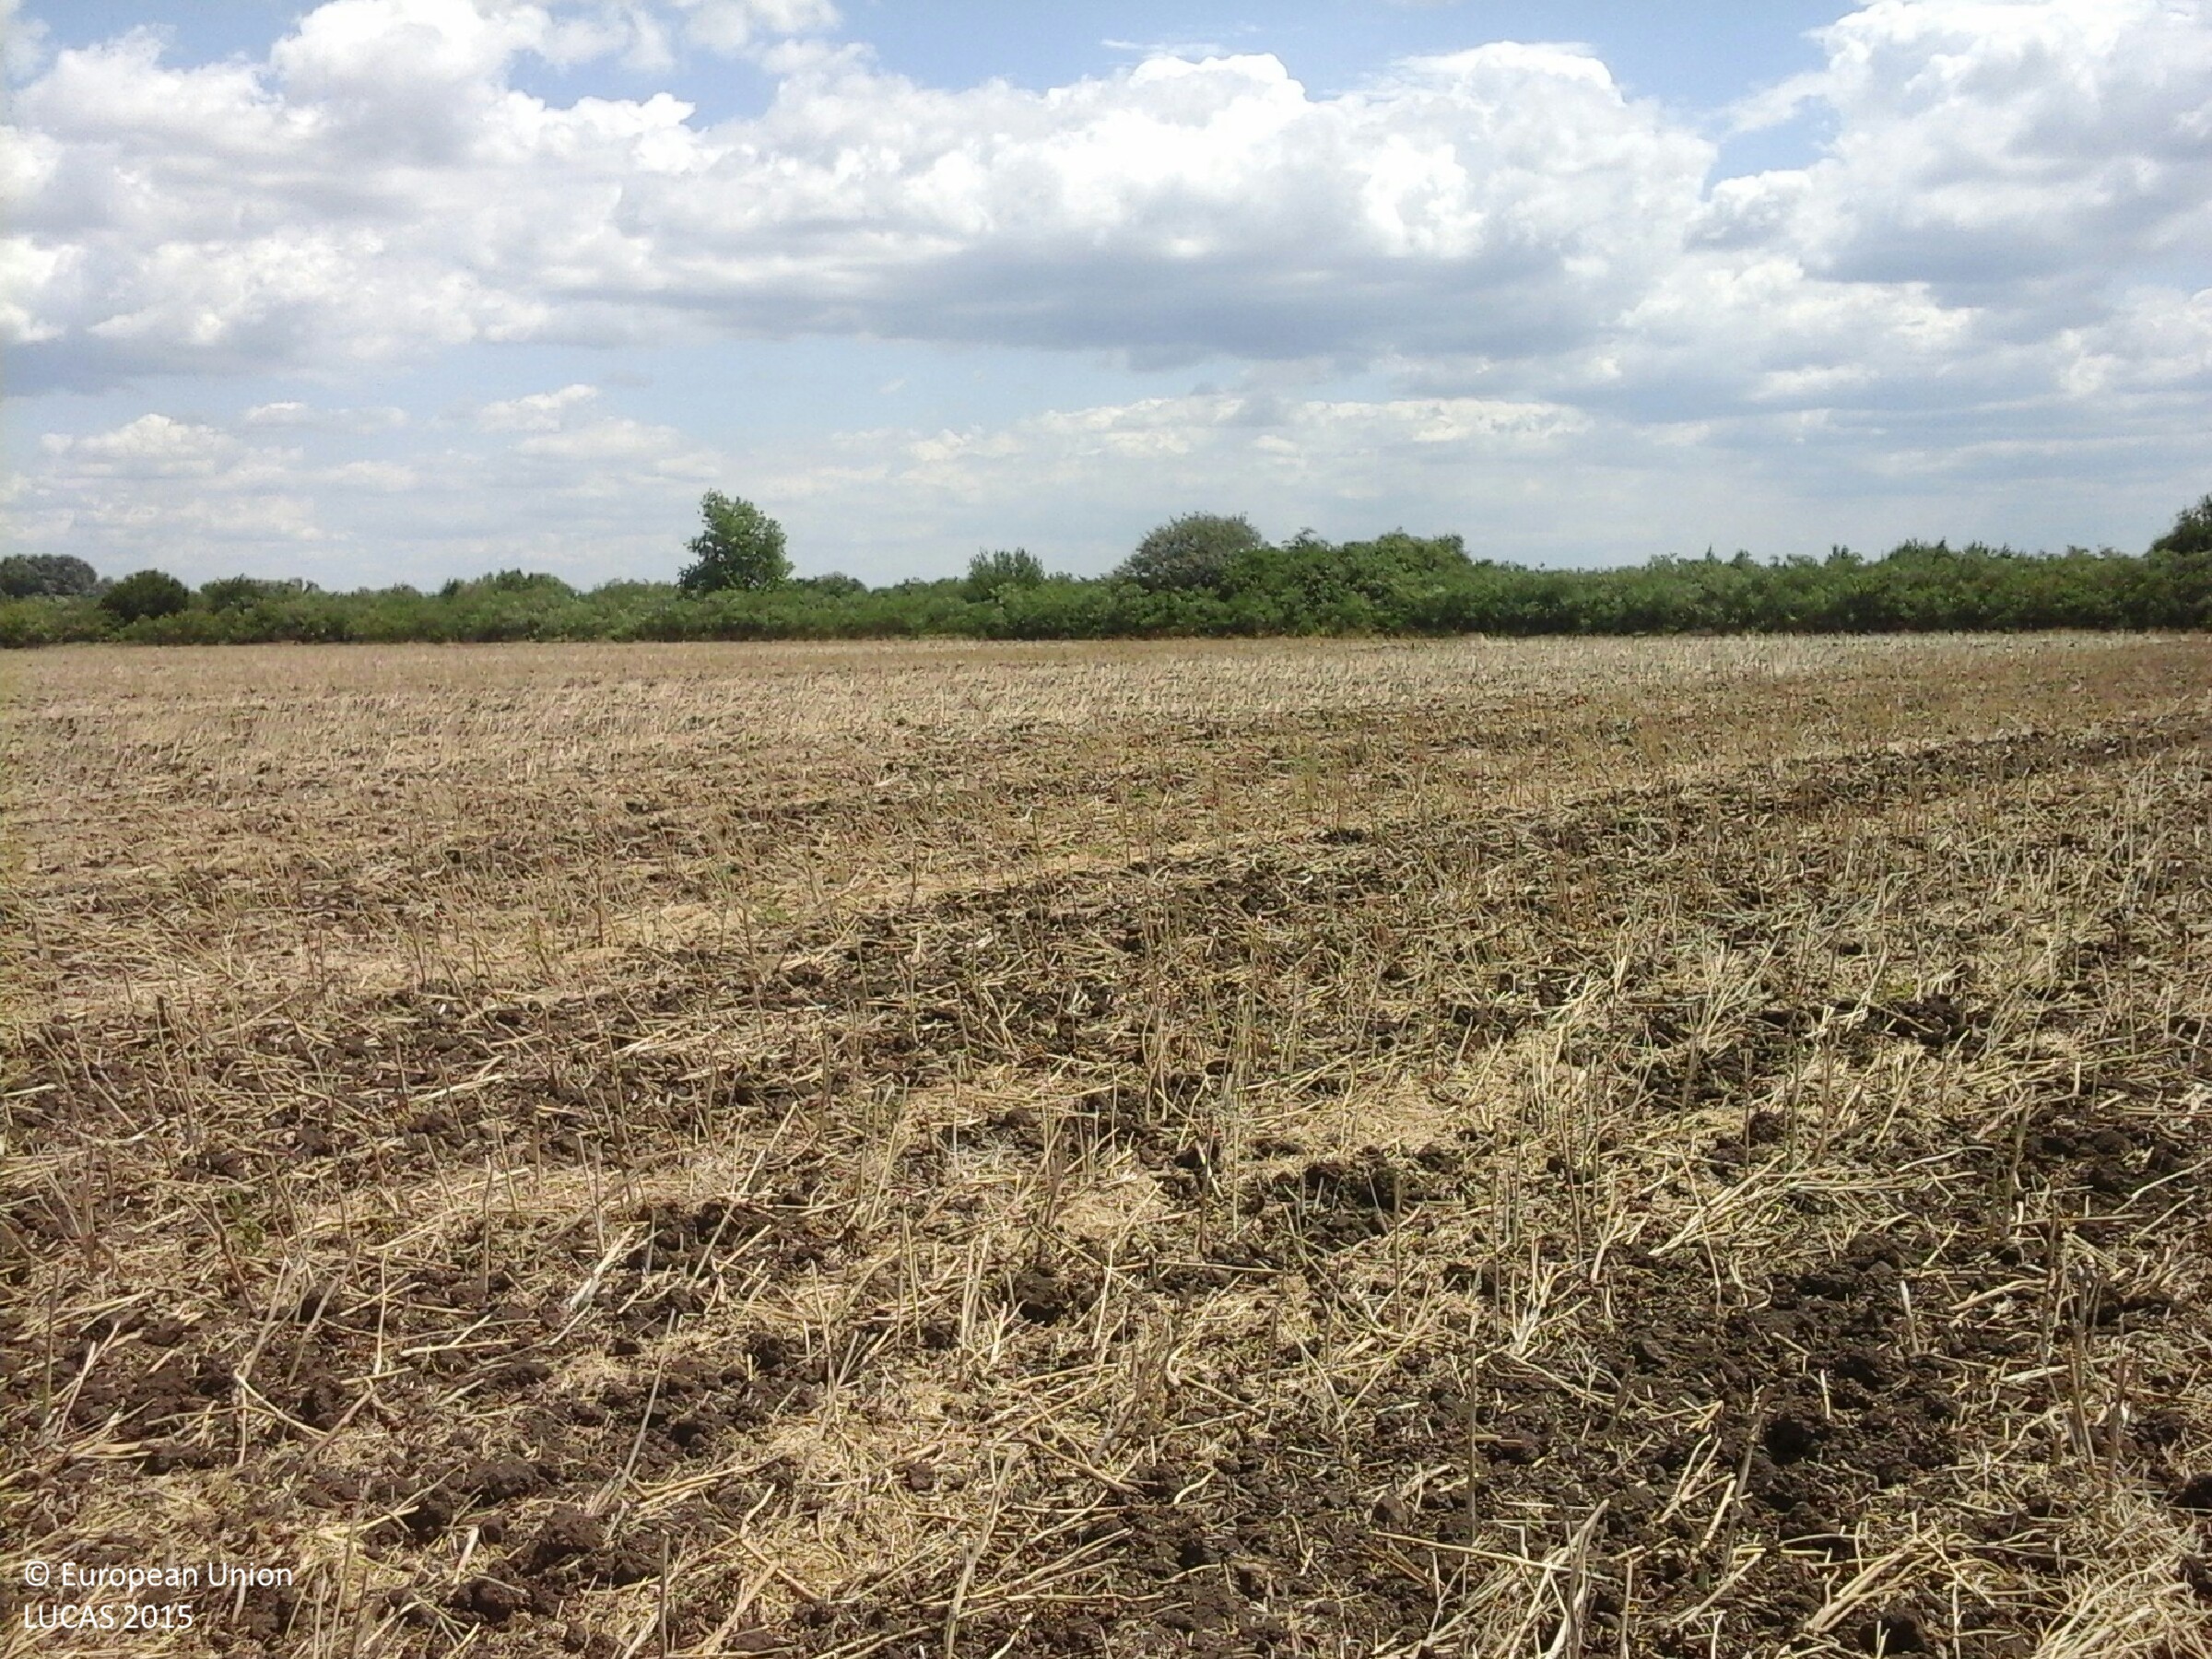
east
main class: Cropland
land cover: Rape and turnip rape
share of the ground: 25 - 50 %
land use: Agriculture (excluding fallow land and kitchen gardens)
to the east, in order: Rape and turnip rape; Shrubland without tree cover; Ditches and canals; Shrubland without tree cover; Common wheat
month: July
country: HU
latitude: 47.8175
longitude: 20.6248
